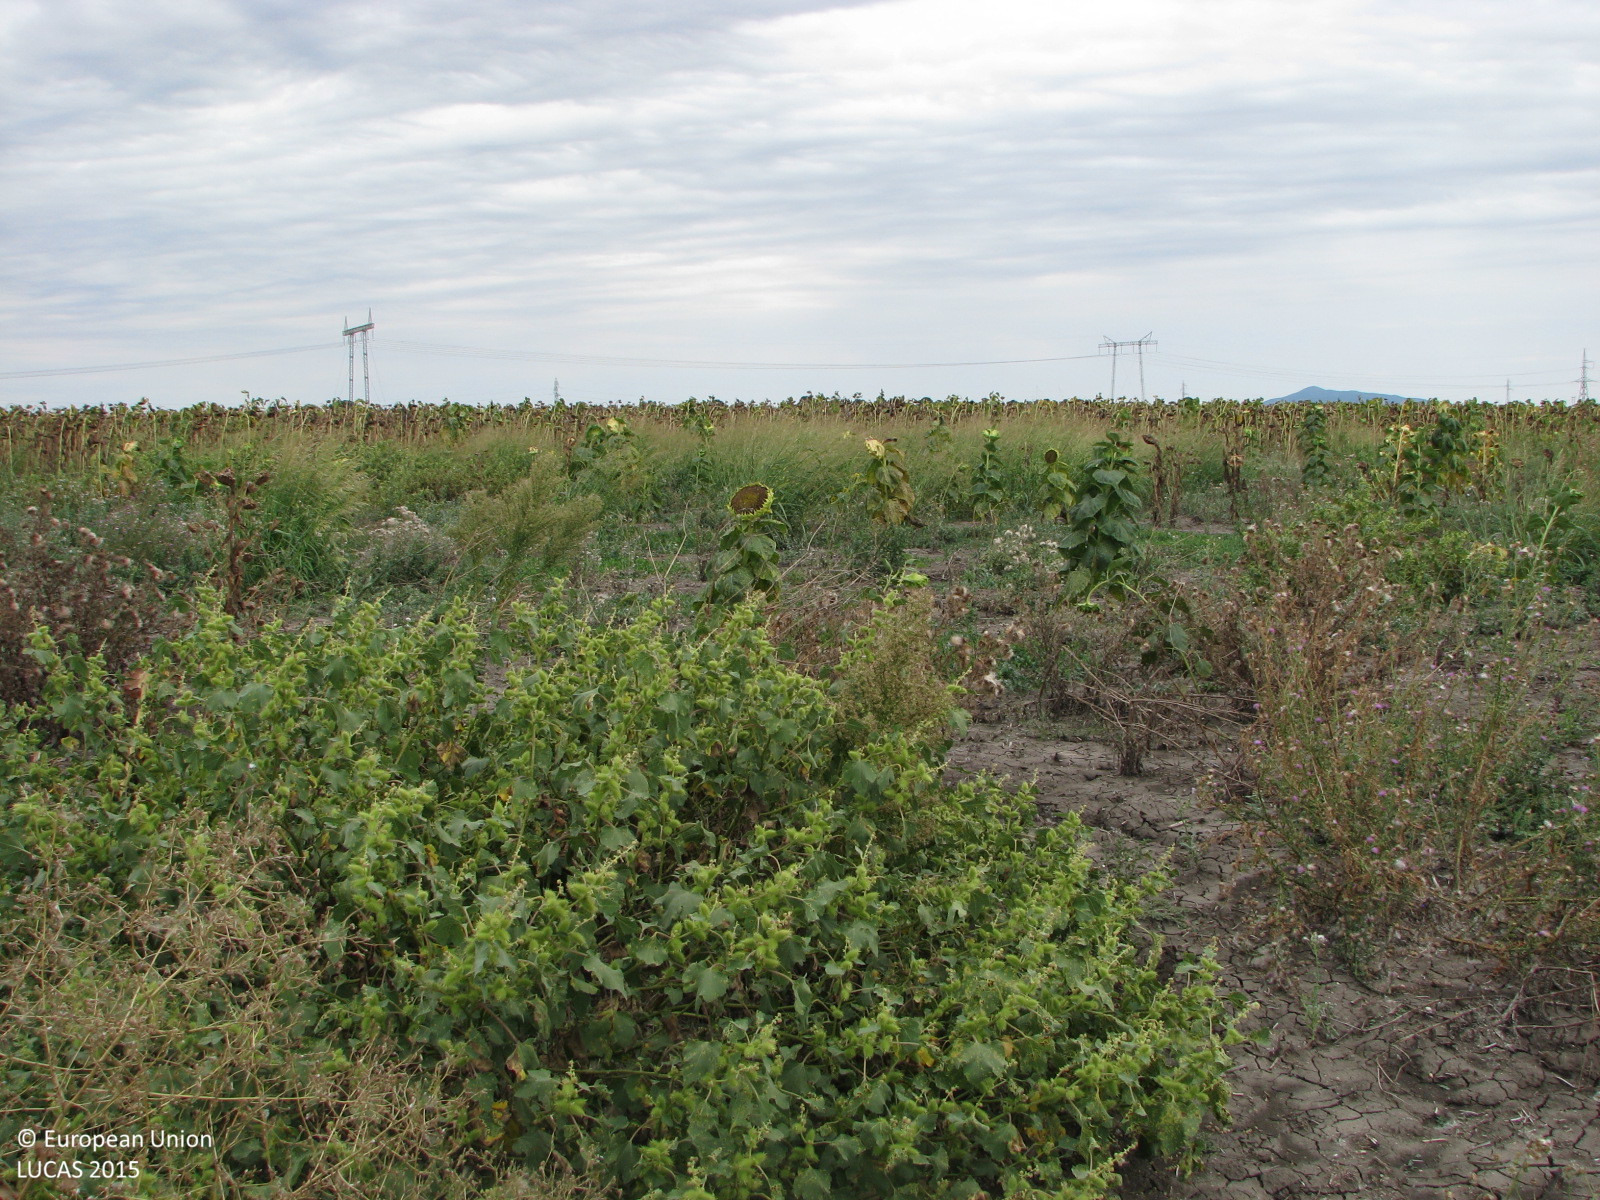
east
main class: Cropland
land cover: Sunflower
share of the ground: 25 - 50 %
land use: Agriculture (excluding fallow land and kitchen gardens)
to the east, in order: Sunflower
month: September
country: BG
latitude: 42.3283
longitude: 26.1120
